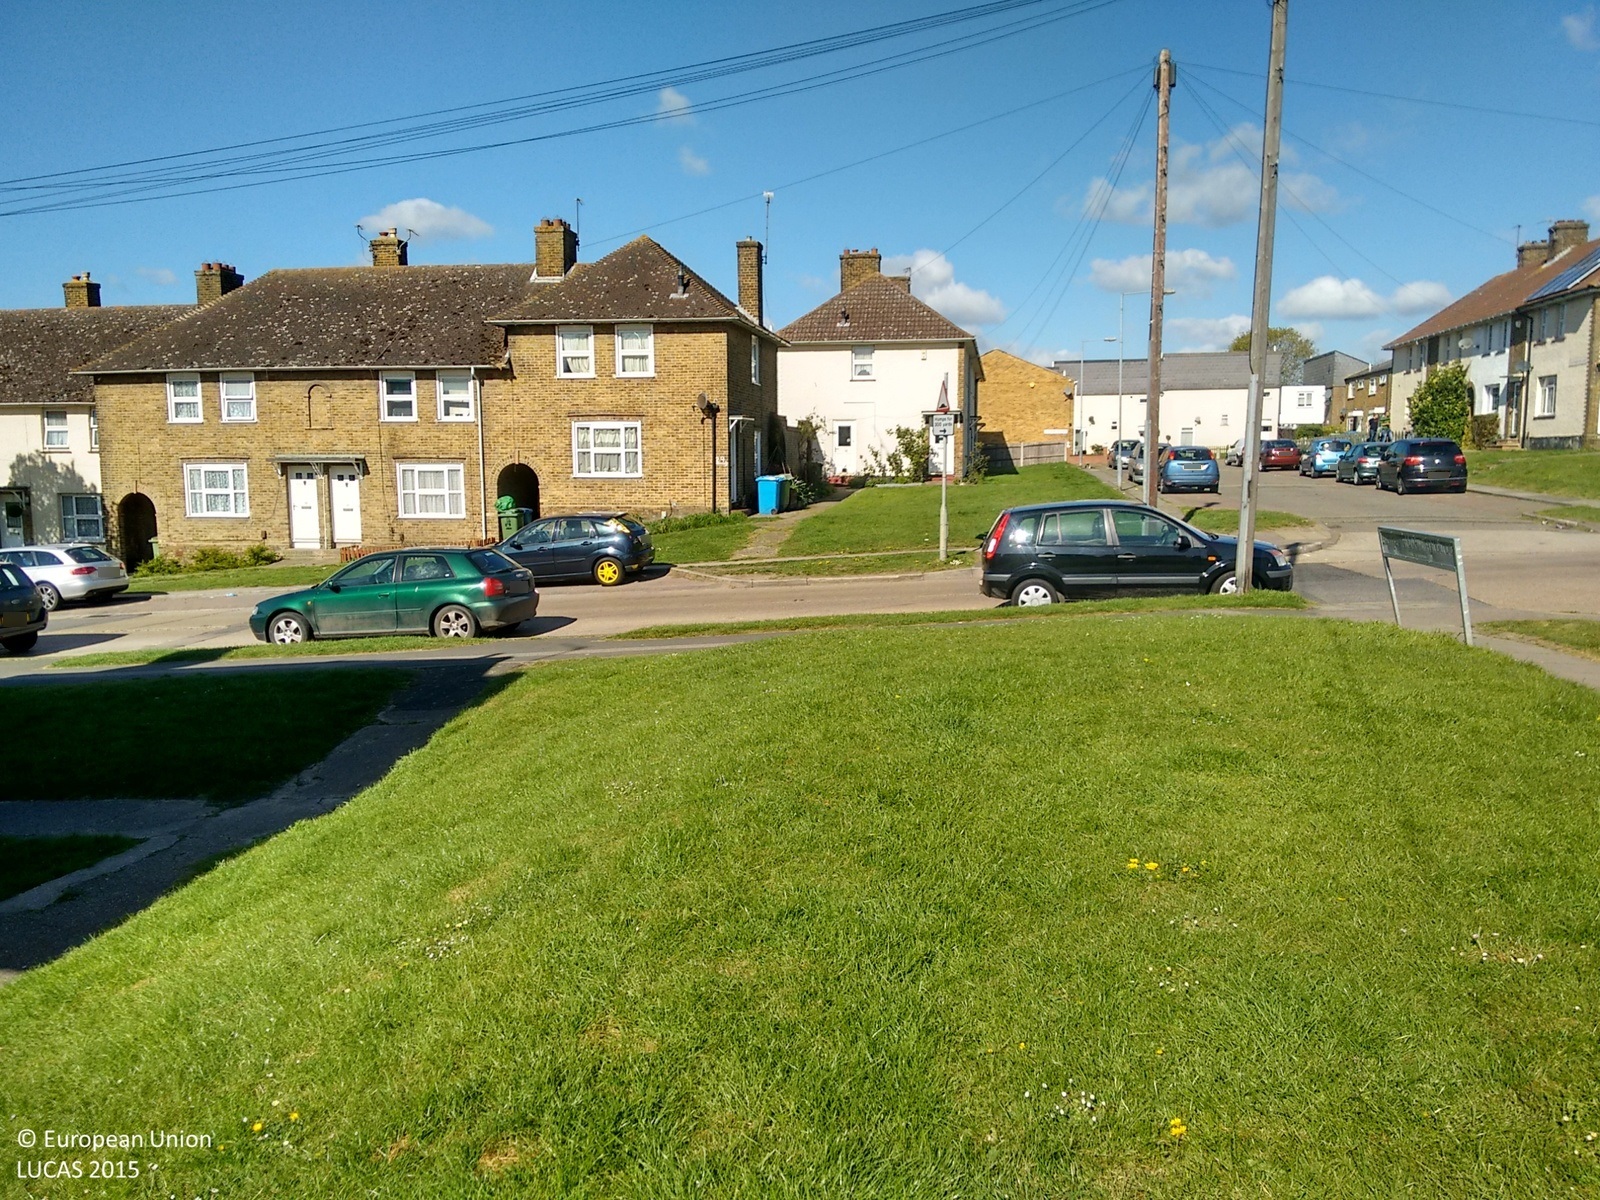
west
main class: Grassland
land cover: Grassland without tree/shrub cover
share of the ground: > 75 %
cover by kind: herbaceous plants 100 %
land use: Residential
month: April
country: GB
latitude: 51.3633
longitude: 0.7393
